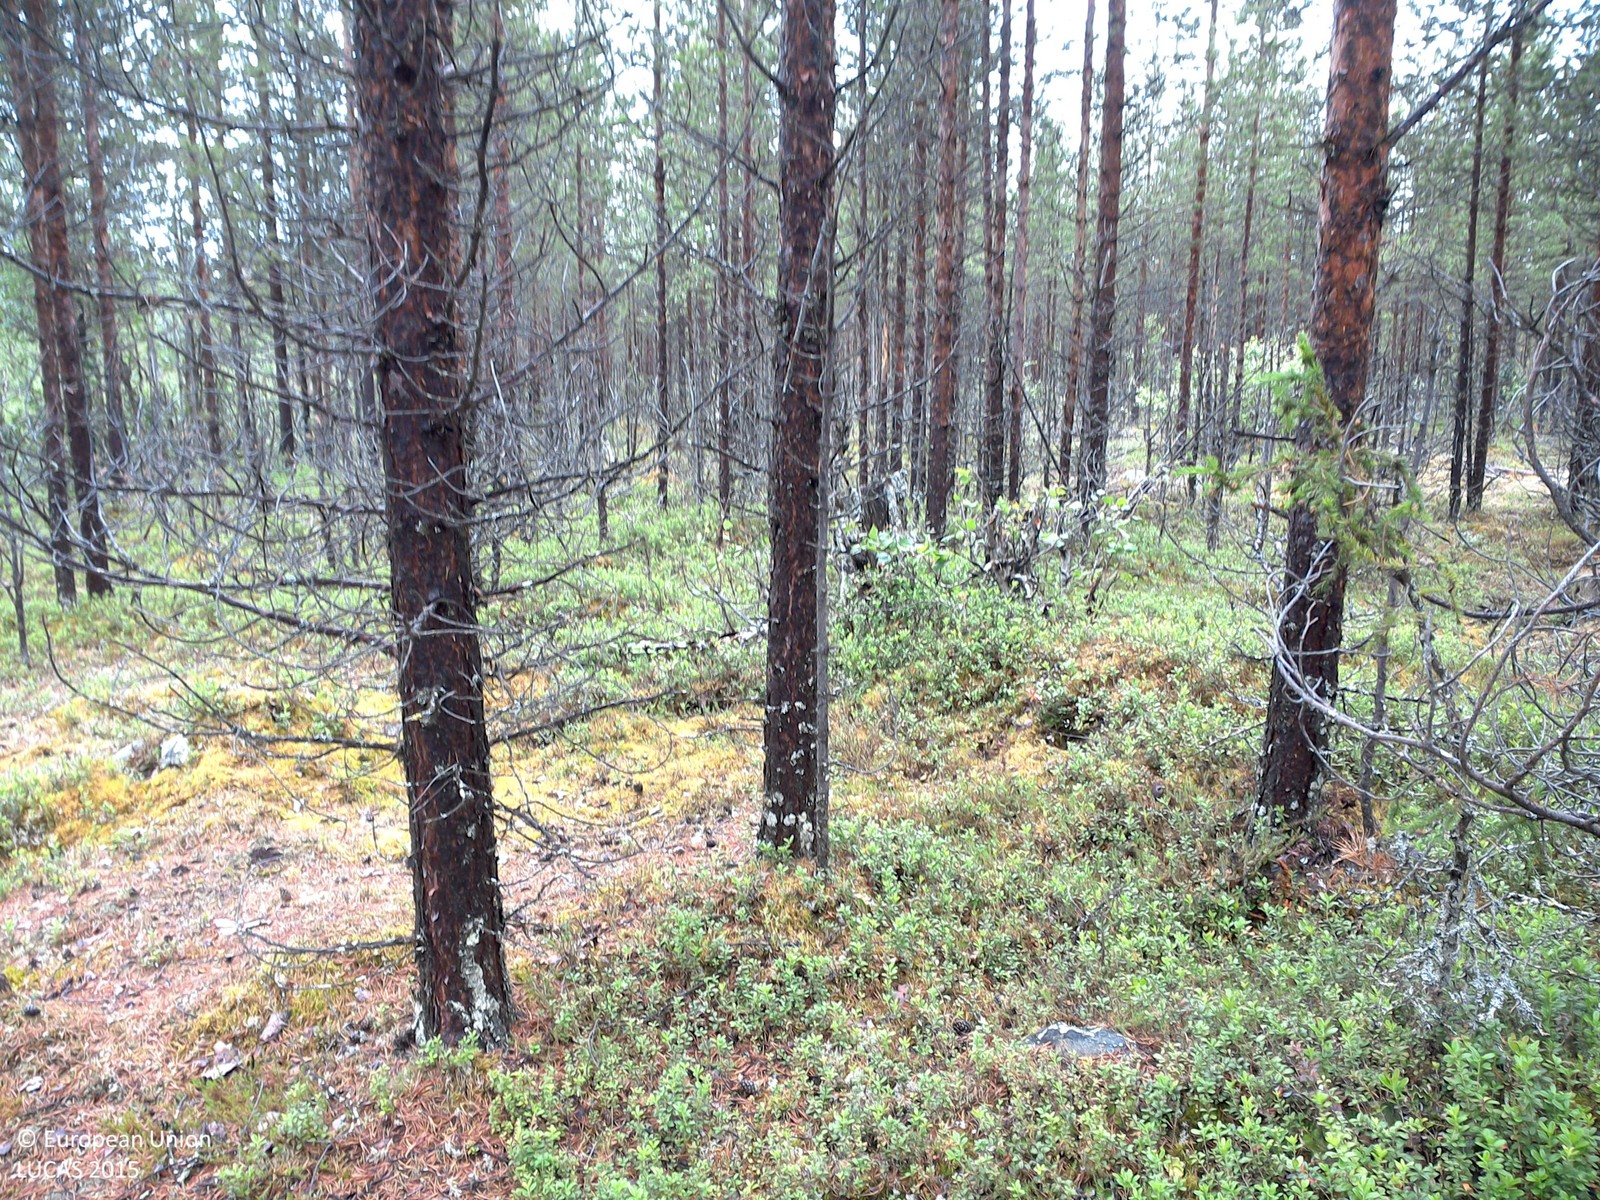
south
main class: Woodland
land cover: Pine dominated coniferous woodland
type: boreal forest
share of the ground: 25 - 50 %
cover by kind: shrubs 50 %, coniferous forest trees 30 %, lichens and mosses 20 %
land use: Forestry
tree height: > 5 m
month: July
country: SE
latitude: 67.6929
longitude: 21.3013
